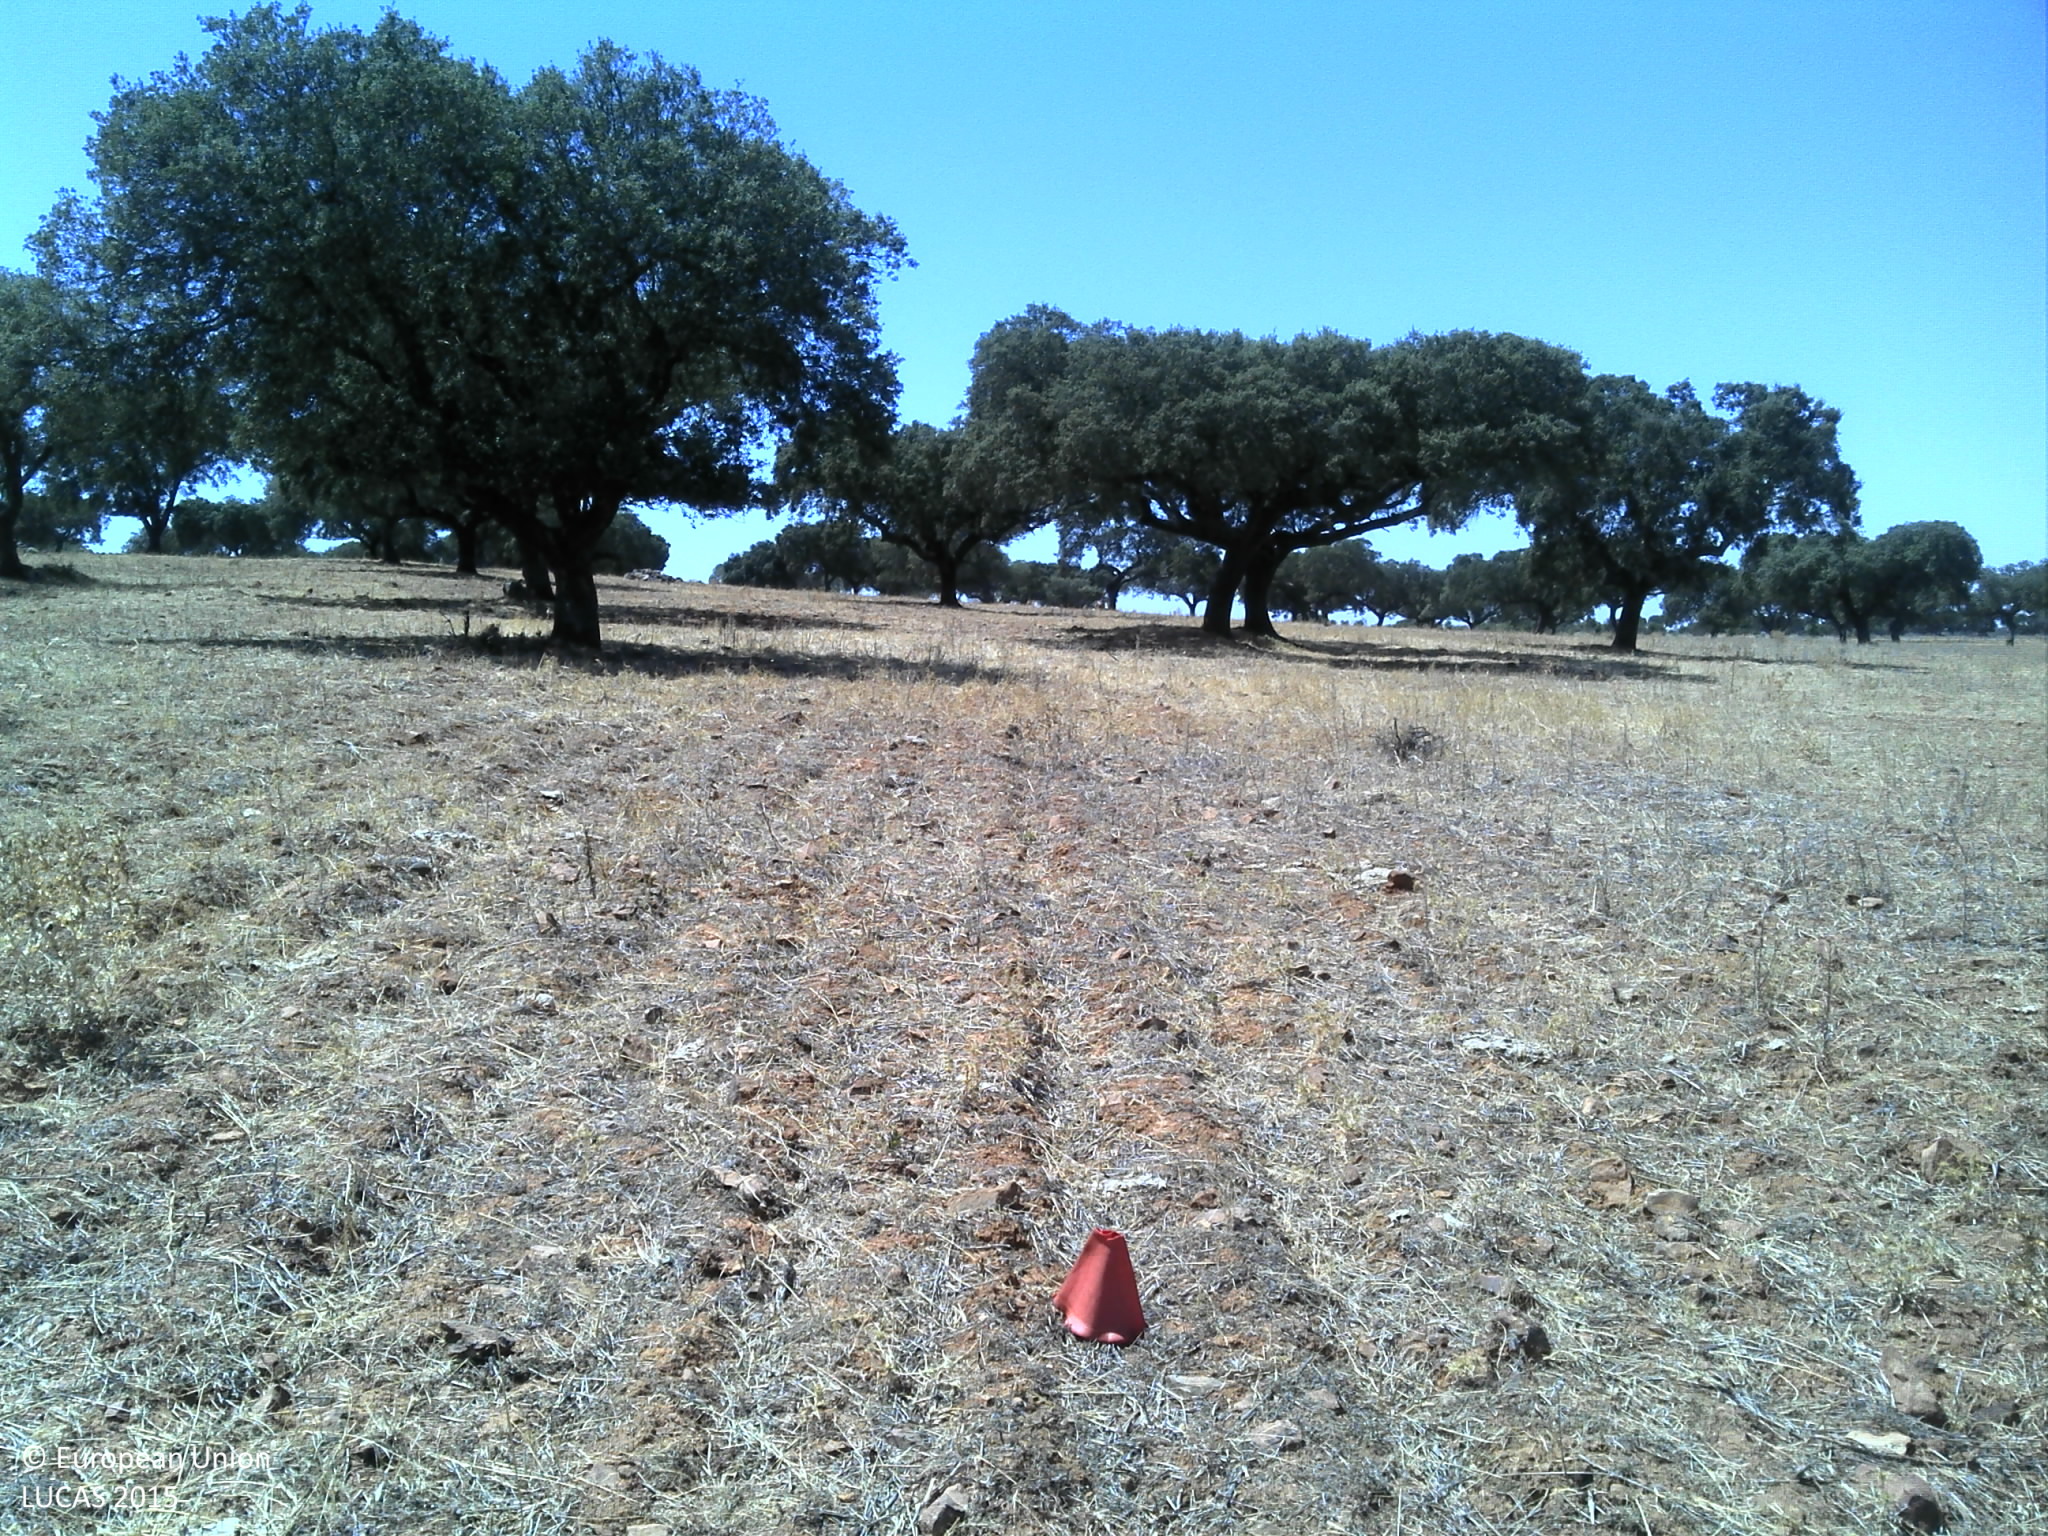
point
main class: Woodland
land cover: Broadleaved woodland
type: broadleaved evergreen forest
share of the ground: 10 - 25 %
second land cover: Grassland without tree/shrub cover
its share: 25 - 50 %
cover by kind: herbaceous plants 45 %, unconsolidated bare surface 35 %, broadleaved forest trees 20 %
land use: Forestry
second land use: Agriculture (excluding fallow land and kitchen gardens)
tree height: > 5 m
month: July
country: PT
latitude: 37.7997
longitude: -7.9585
